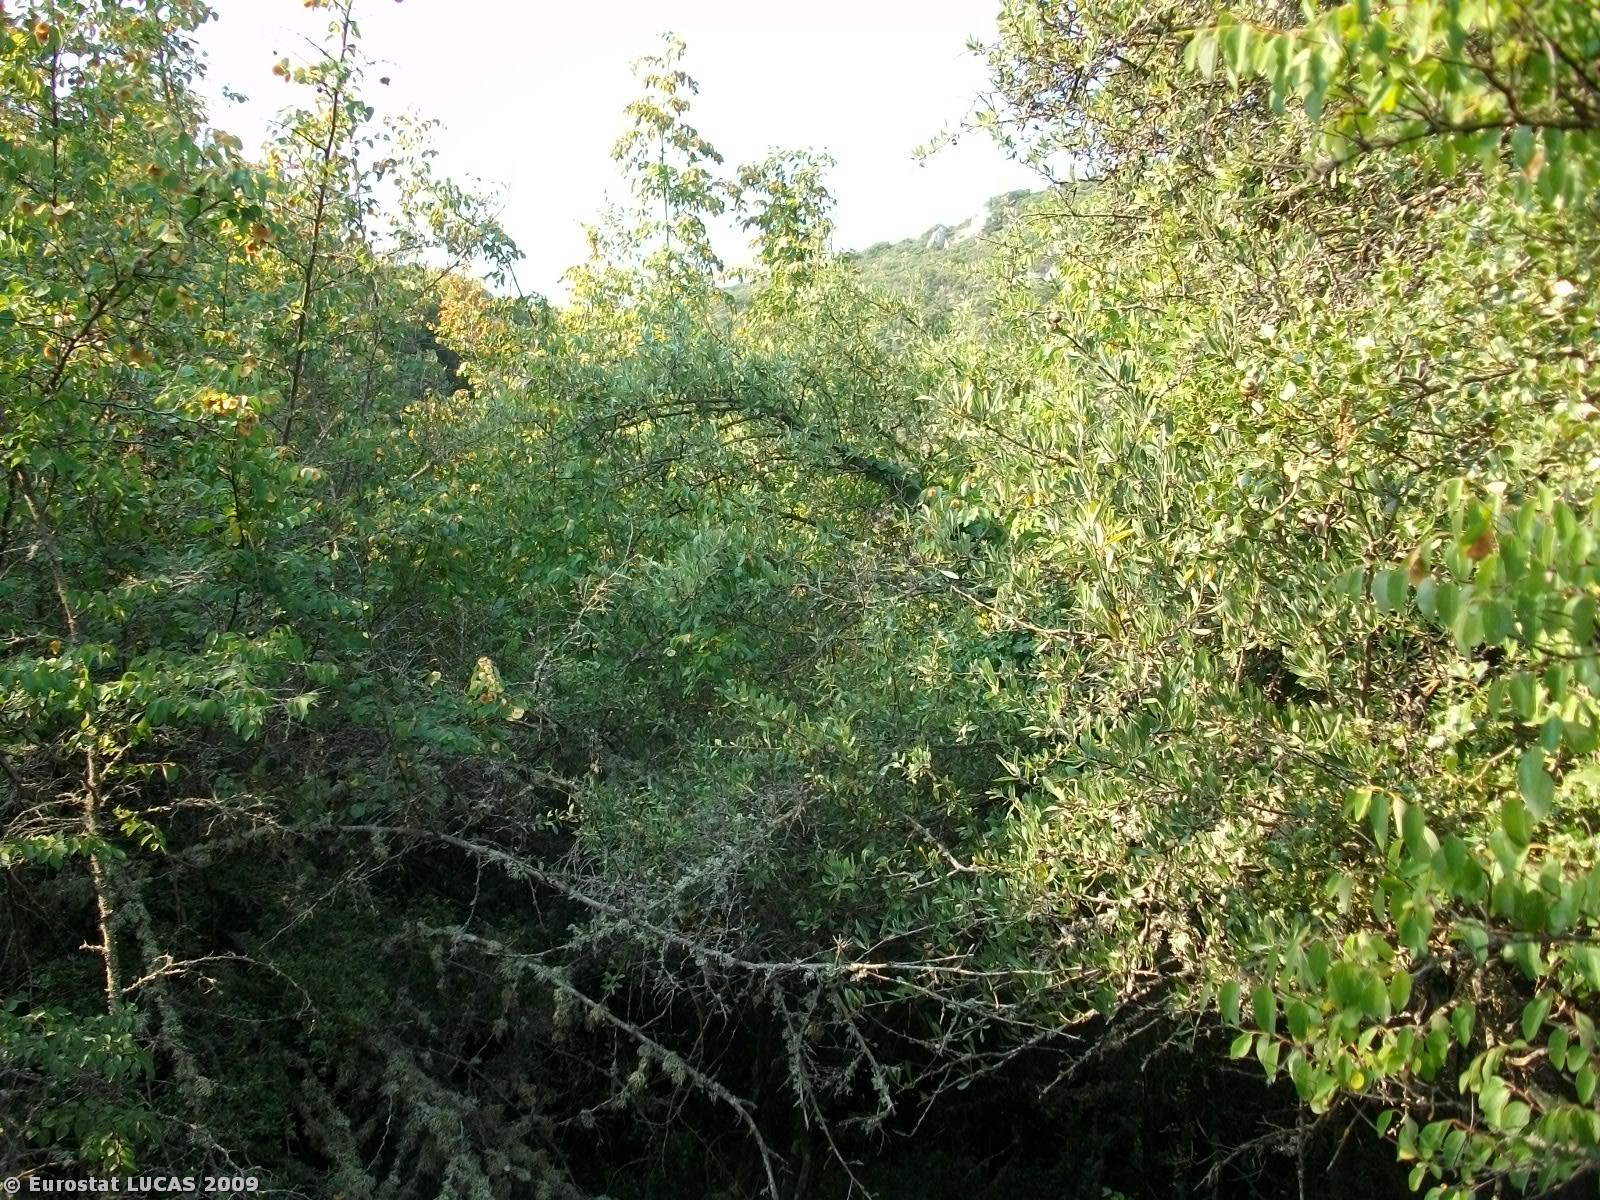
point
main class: Woodland
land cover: Broadleaved woodland
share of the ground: 50 - 75 %
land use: Forestry
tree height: < 5 m
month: August
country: GR
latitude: 38.7615
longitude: 22.4191
